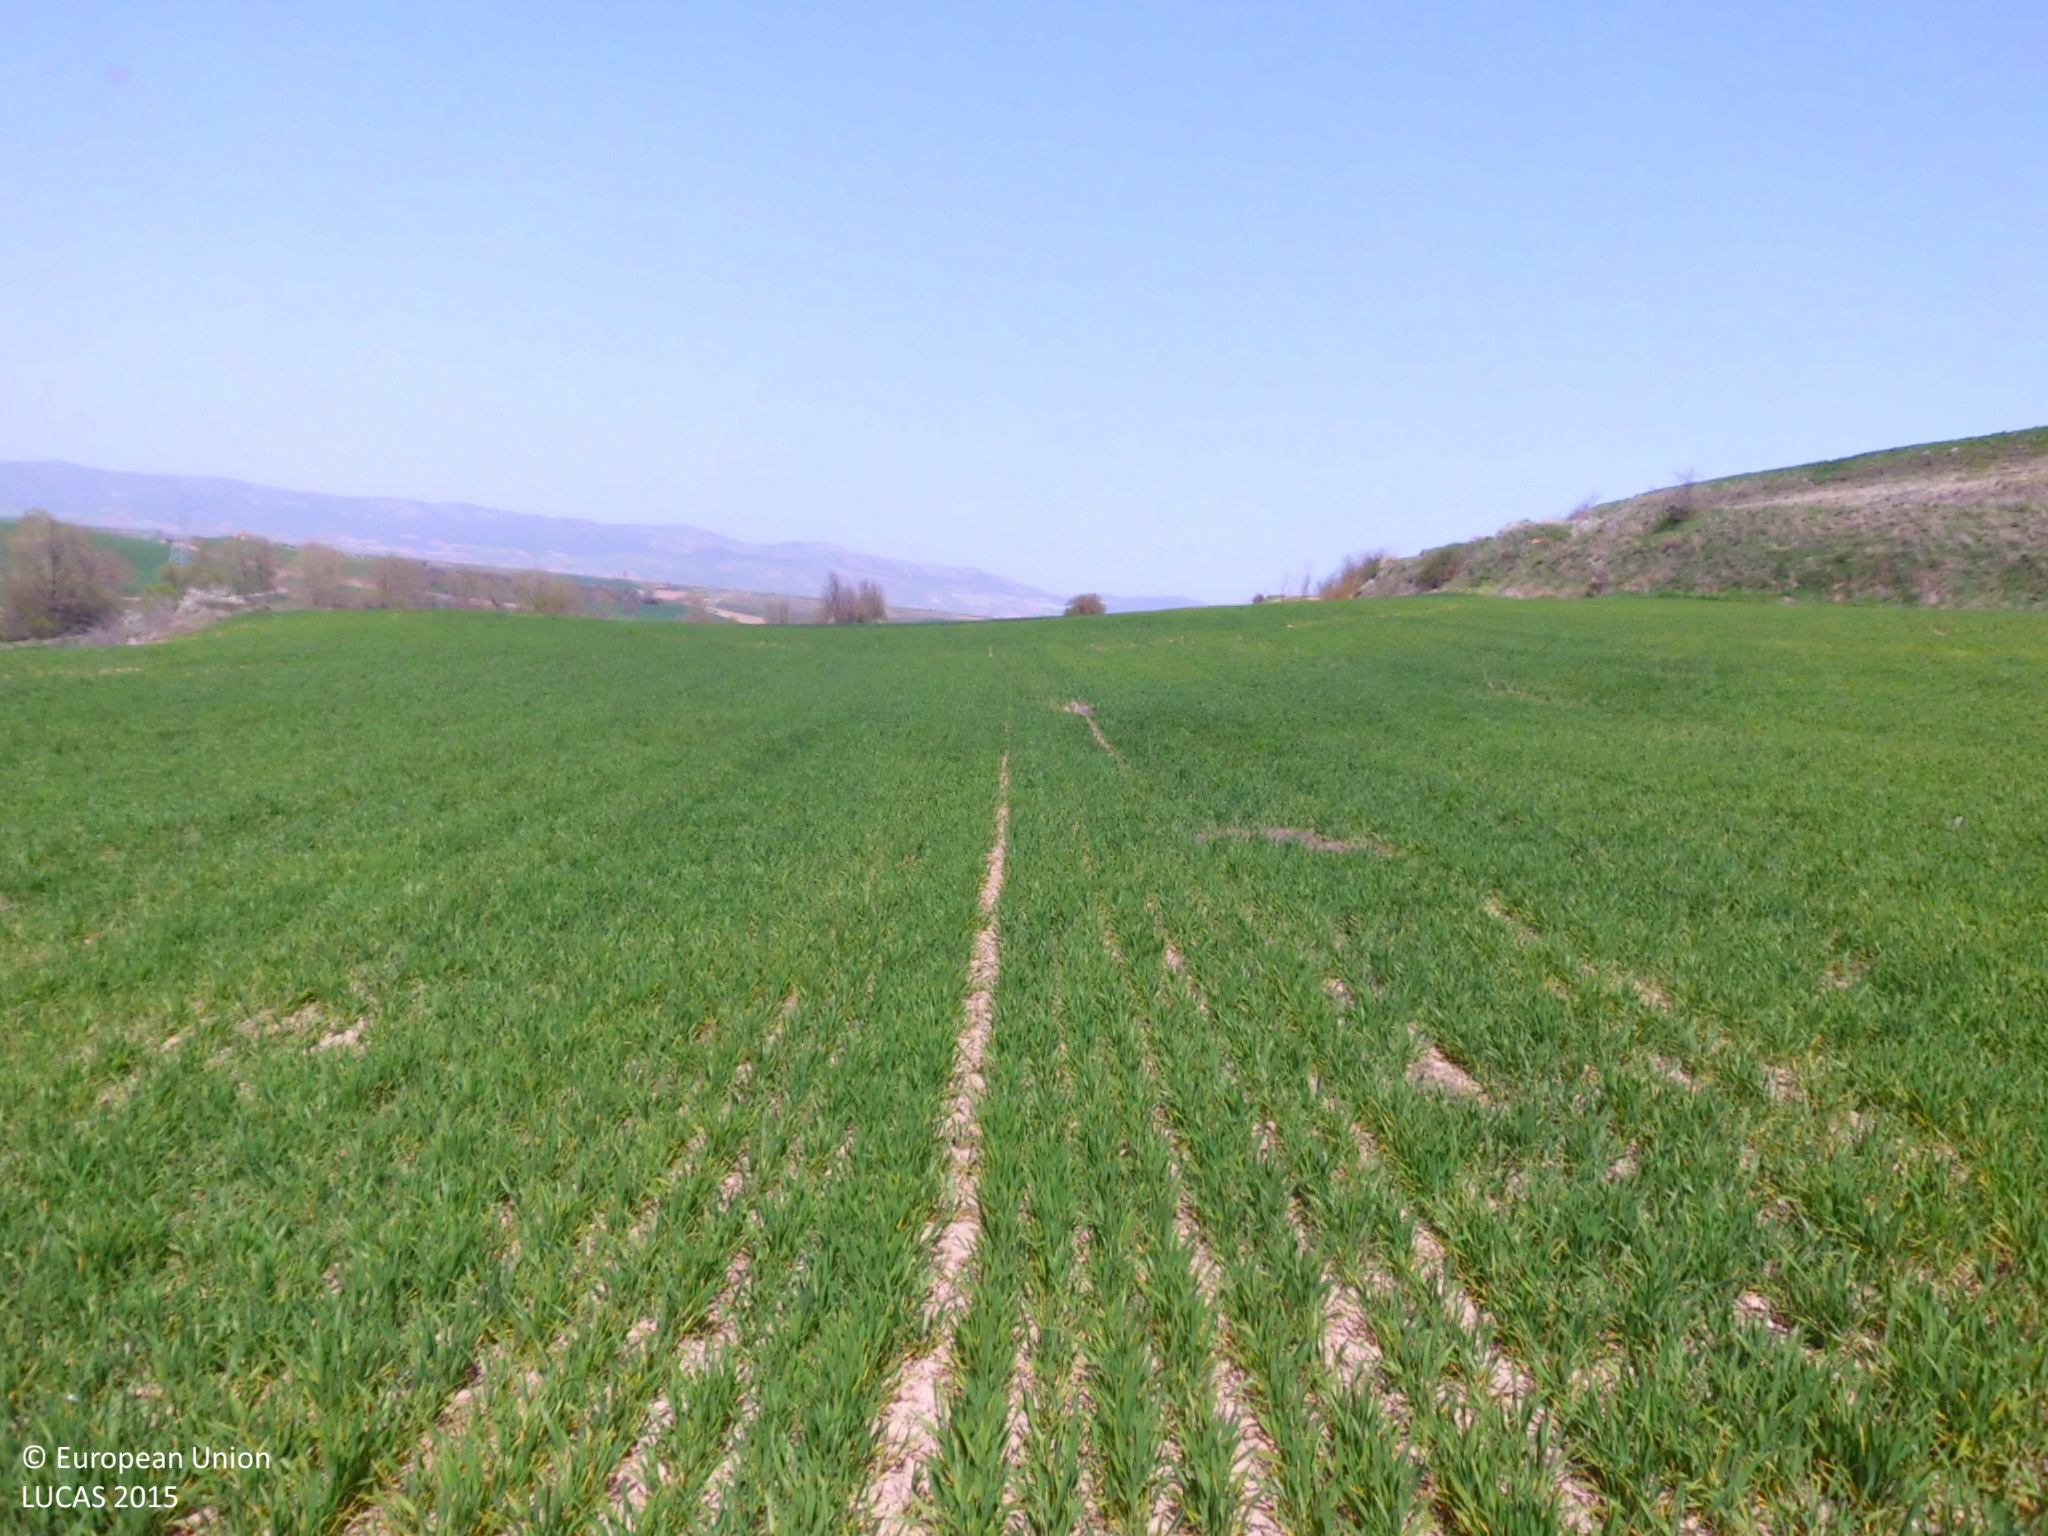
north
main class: Cropland
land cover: Barley
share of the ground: 50 - 75 %
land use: Agriculture (excluding fallow land and kitchen gardens)
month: April
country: ES
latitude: 42.5735
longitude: -3.3245
